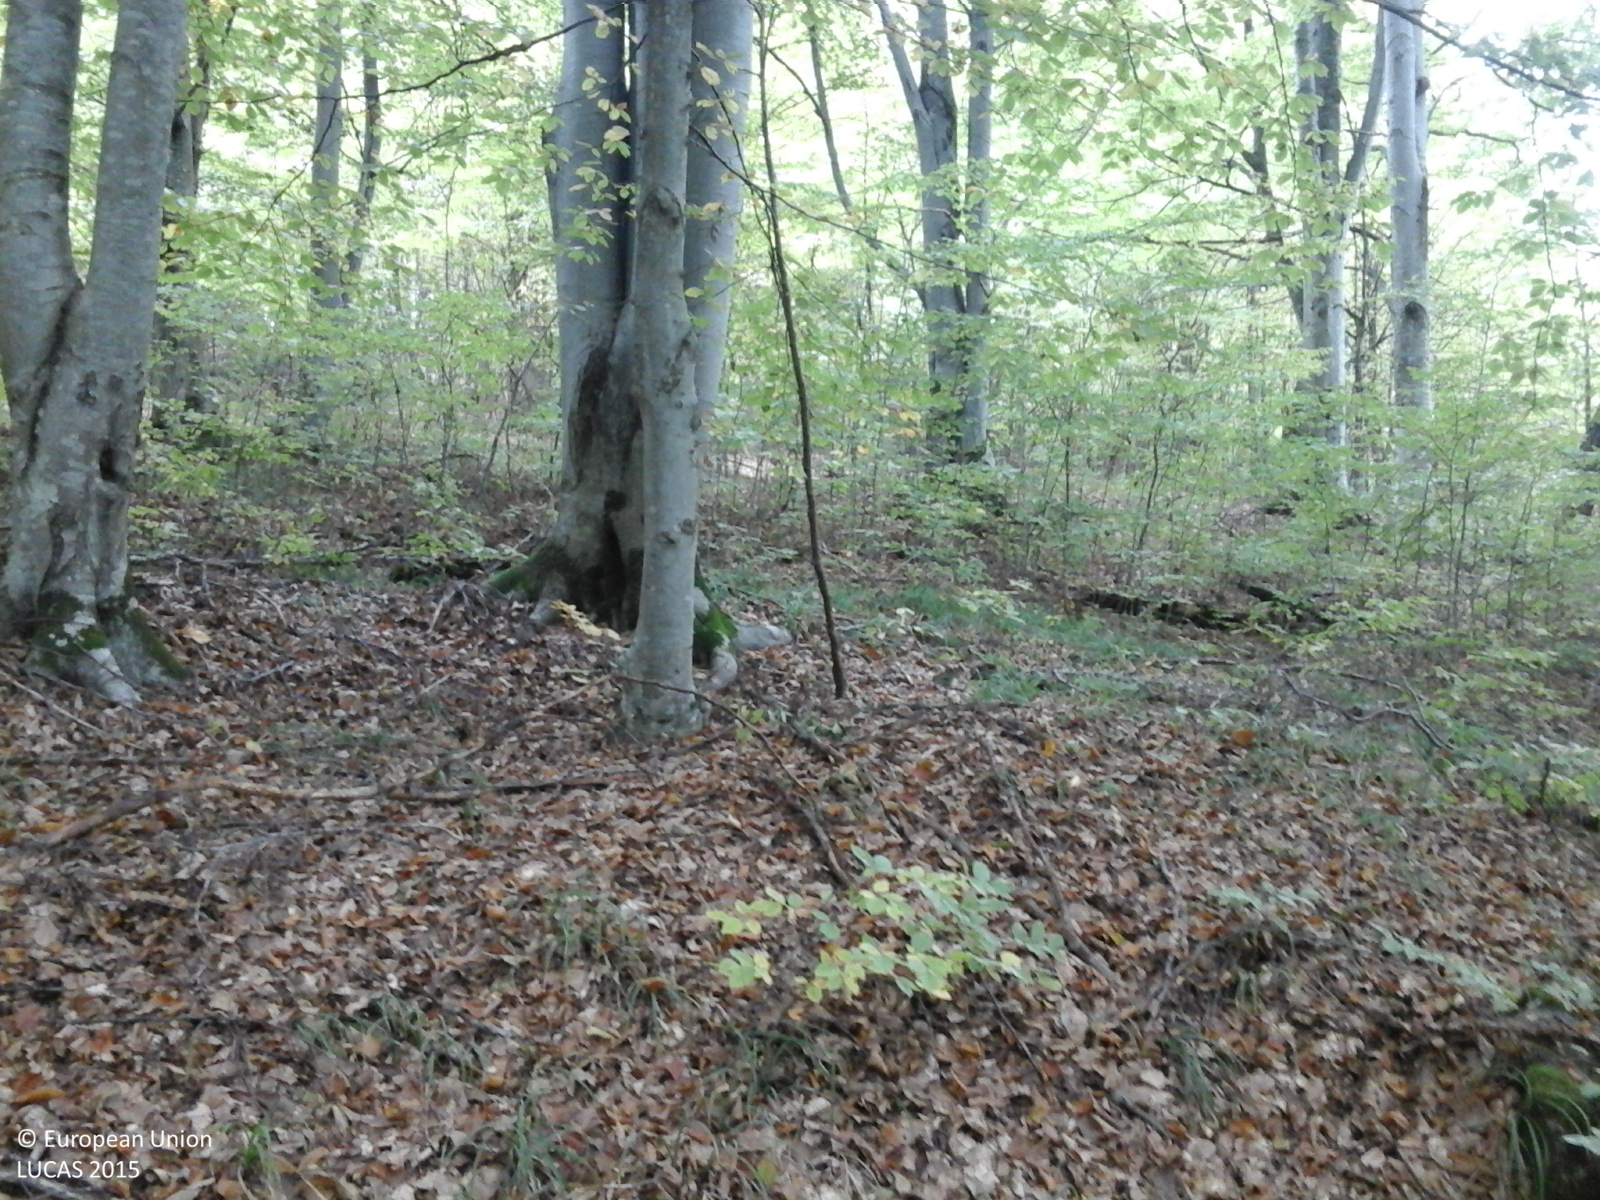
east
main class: Woodland
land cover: Broadleaved woodland
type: beech forest
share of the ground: > 75 %
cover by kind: broadleaved forest trees 100 %
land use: Forestry
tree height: > 5 m
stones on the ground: 10 - 25 %
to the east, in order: Broadleaved woodland; Tracks; Broadleaved woodland; Tracks; Broadleaved woodland; Grassland without tree/shrub cover; Fences; Grassland without tree/shrub cover
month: October
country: RO
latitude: 46.6540
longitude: 25.0350
